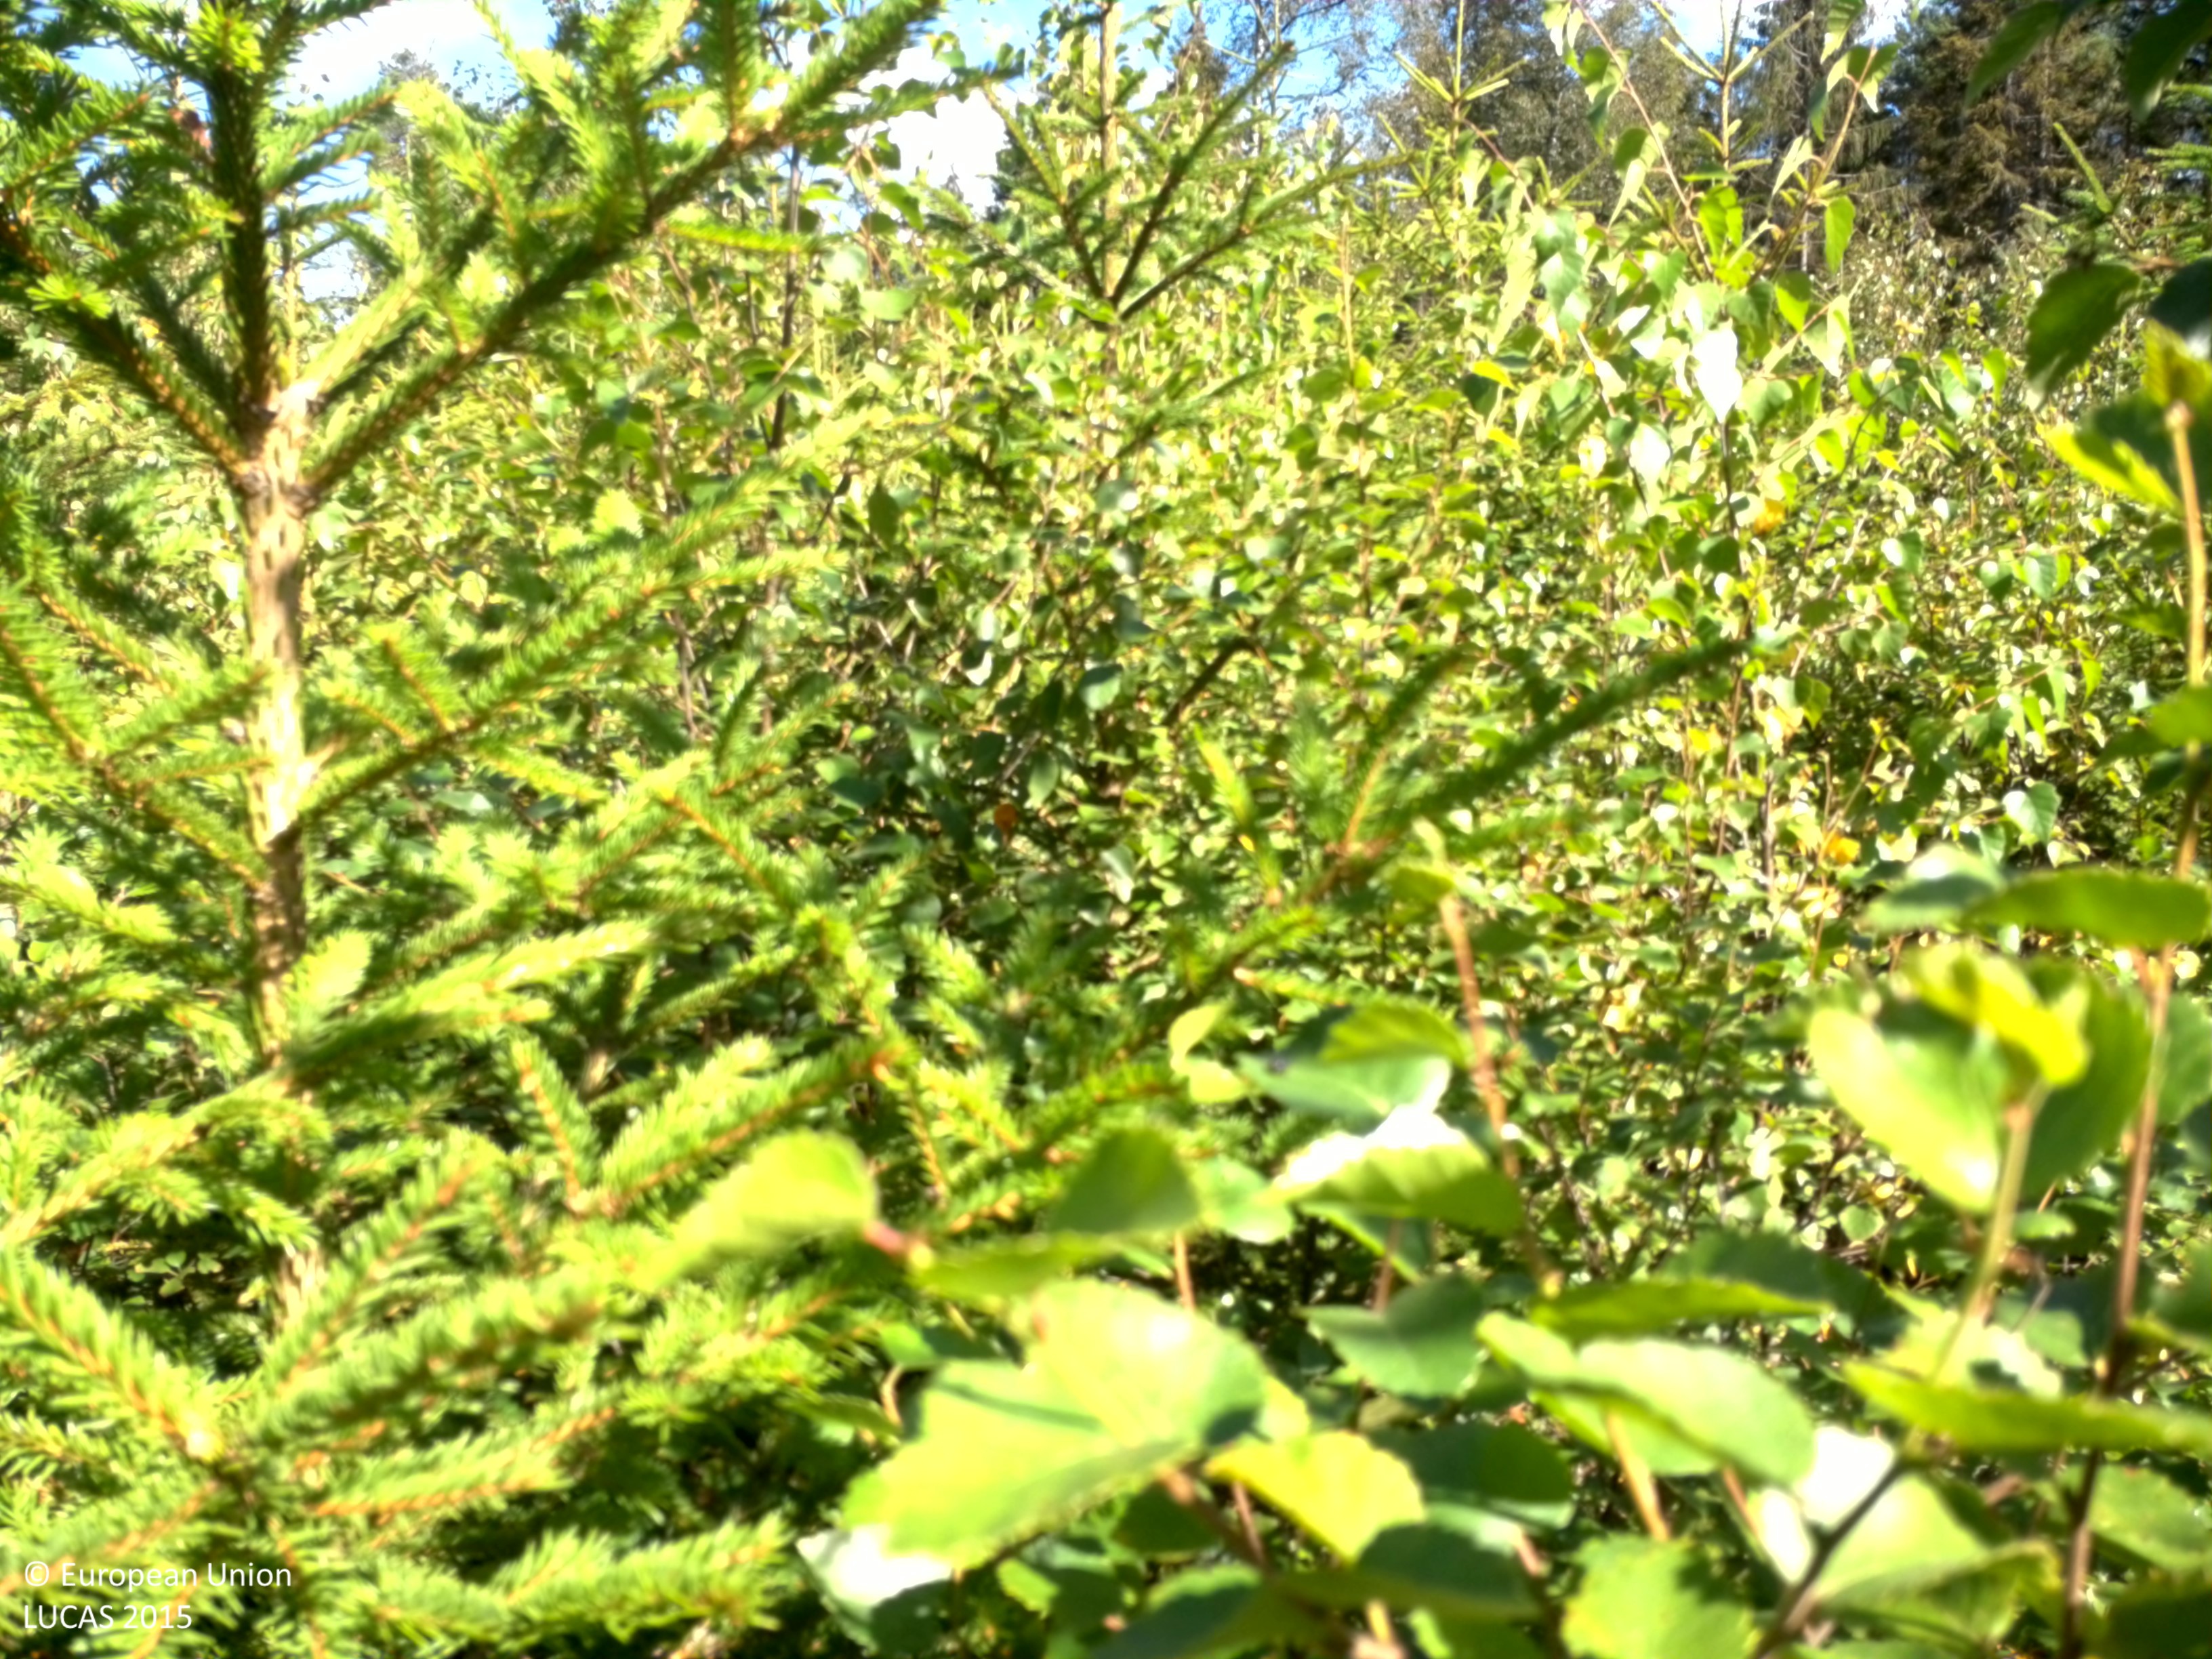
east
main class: Woodland
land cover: Spruce dominated mixed woodland
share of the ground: > 75 %
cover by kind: coniferous forest trees 50 %, broadleaved forest trees 45 %, herbaceous plants 5 %
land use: Forestry
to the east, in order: Spruce dominated mixed woodland; Spruce dominated coniferous woodland; Ditches and canals; Spruce dominated mixed woodland; Tracks; Spruce dominated coniferous woodland; Ditches and canals; Spruce dominated coniferous woodland; Pine dominated coniferous woodland
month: August
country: SE
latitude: 58.2498
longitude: 13.3509
